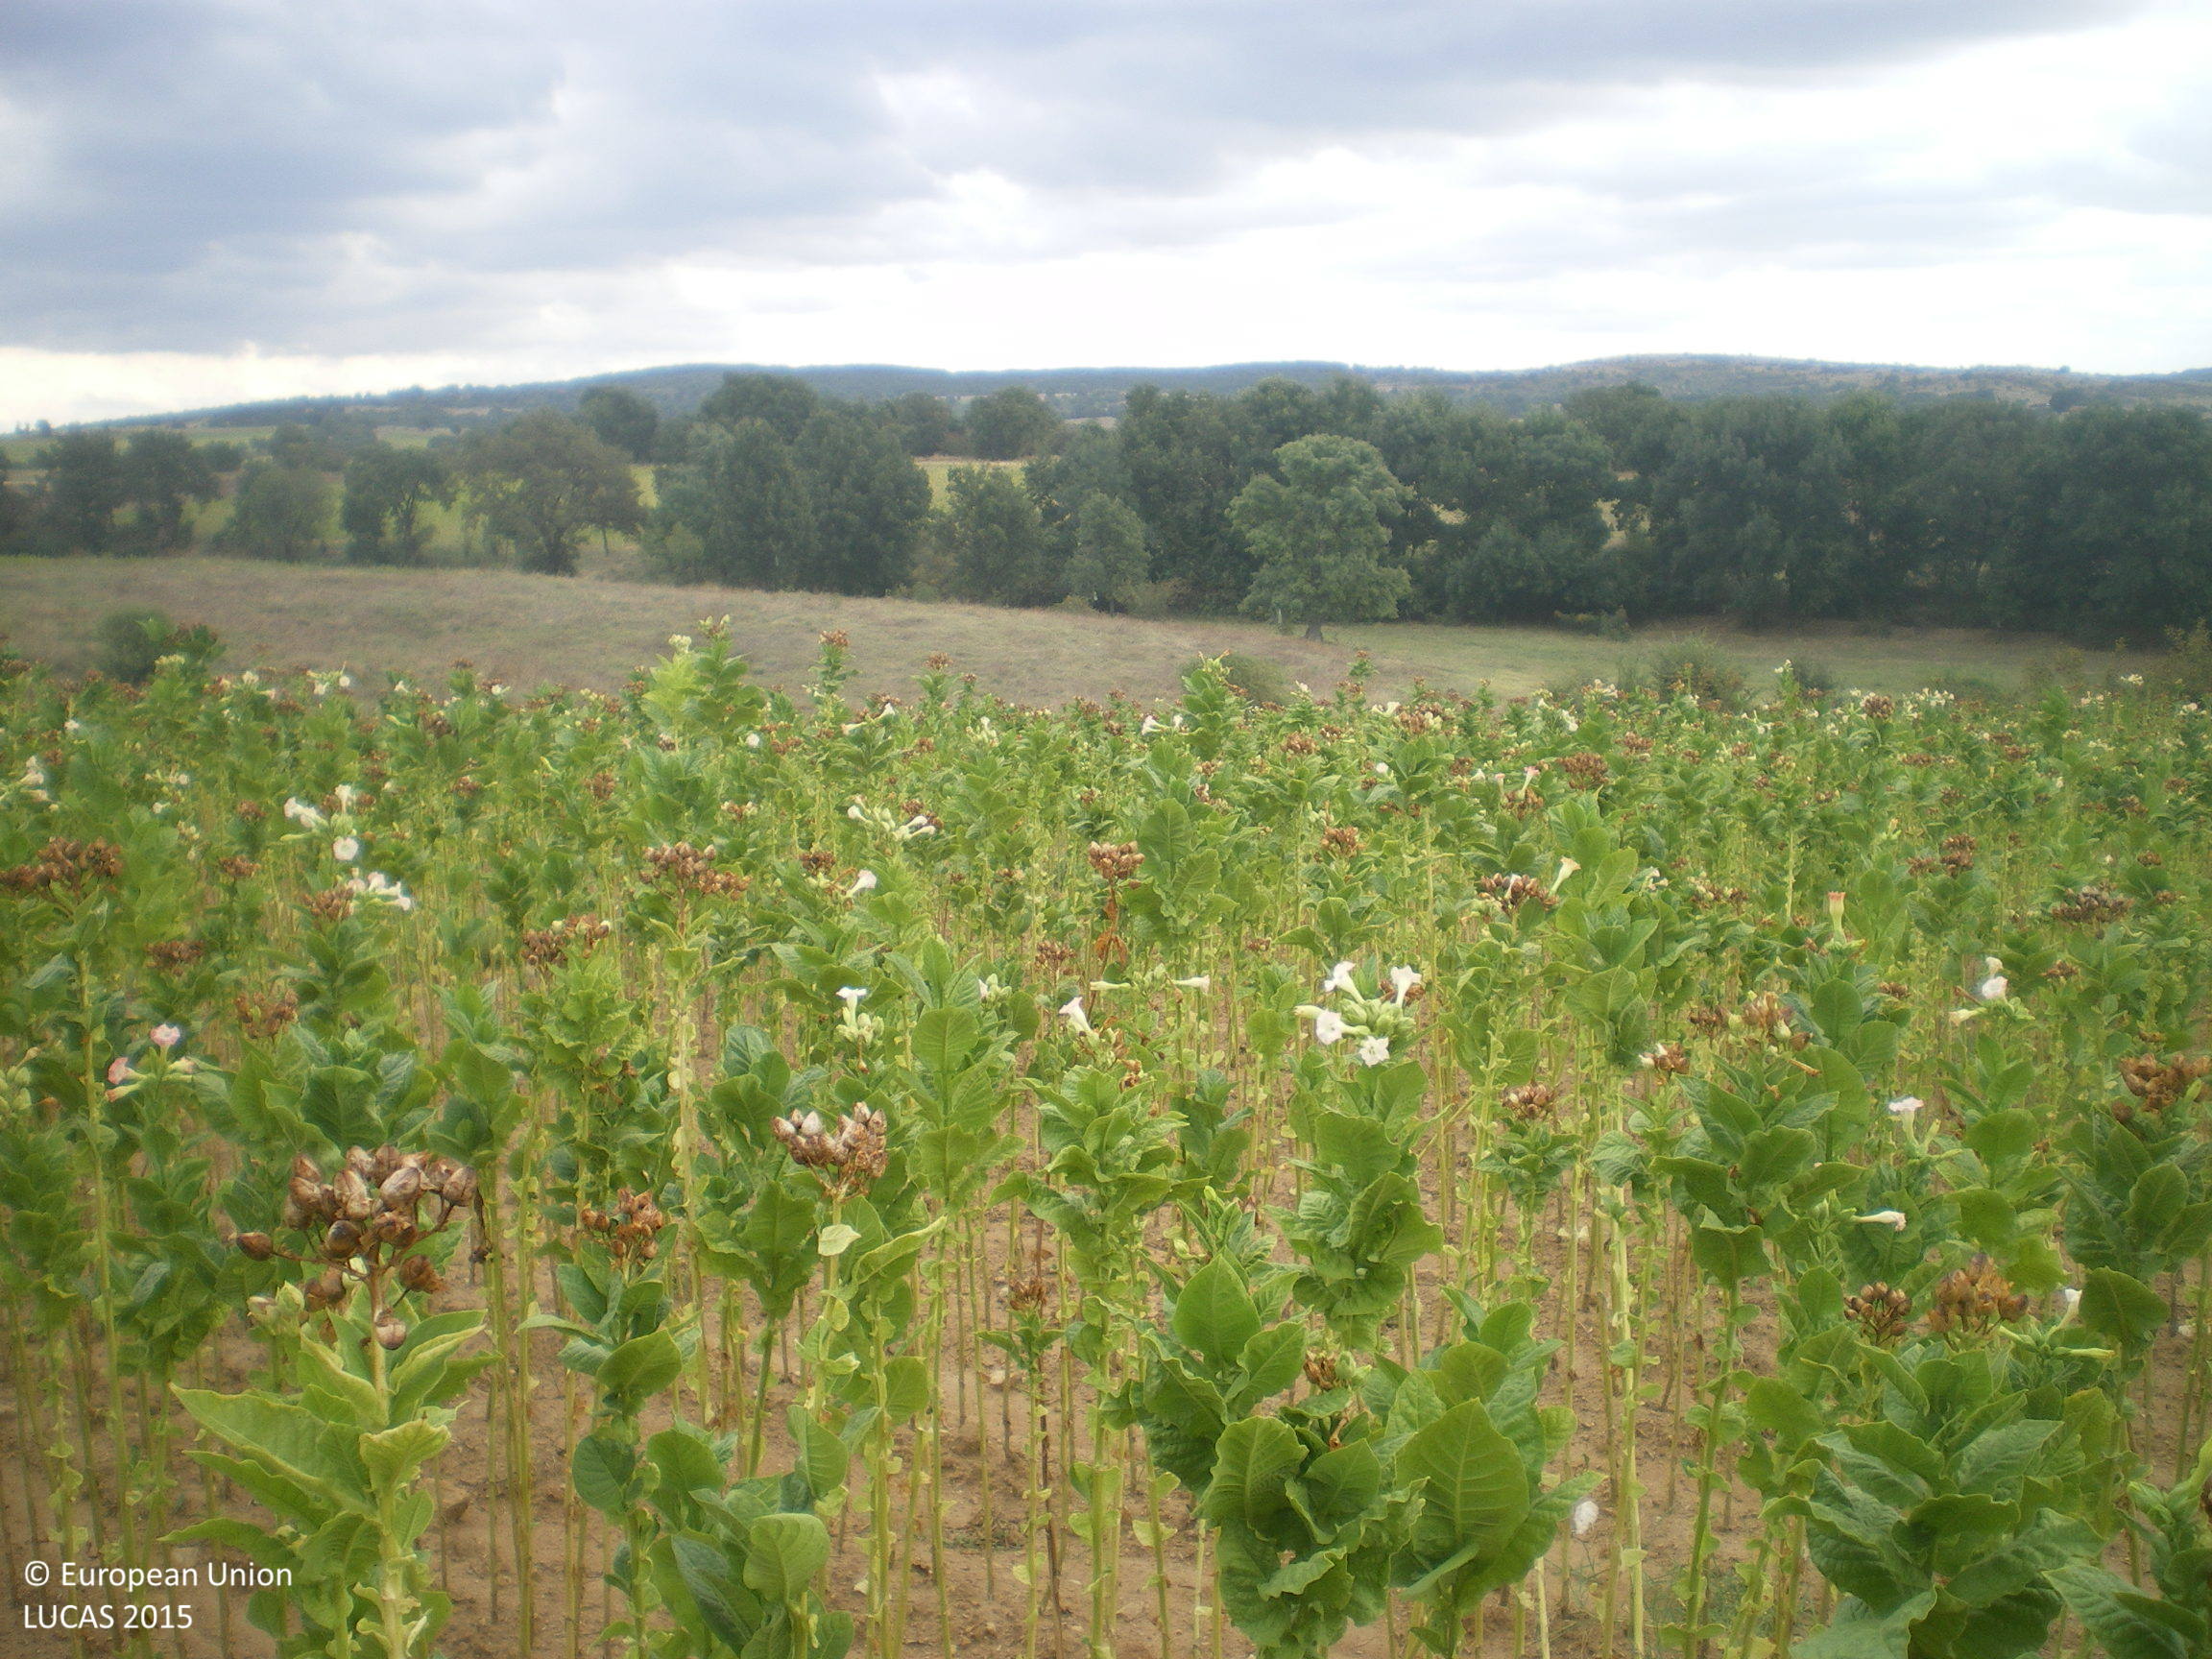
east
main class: Cropland
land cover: Tobacco
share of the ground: > 75 %
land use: Agriculture (excluding fallow land and kitchen gardens)
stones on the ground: > 50 %
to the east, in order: Tobacco; Common wheat; Shrubland with sparse tree cover; Grassland without tree/shrub cover; Single bushes/trees; Grassland without tree/shrub cover; Broadleaved woodland; Shrubland with sparse tree cover; Other fresh vegetables; Tracks; Tobacco; Grass margins; Tracks; Grassland with sparse tree/shrub cover
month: September
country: BG
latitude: 41.9738
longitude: 25.9174
